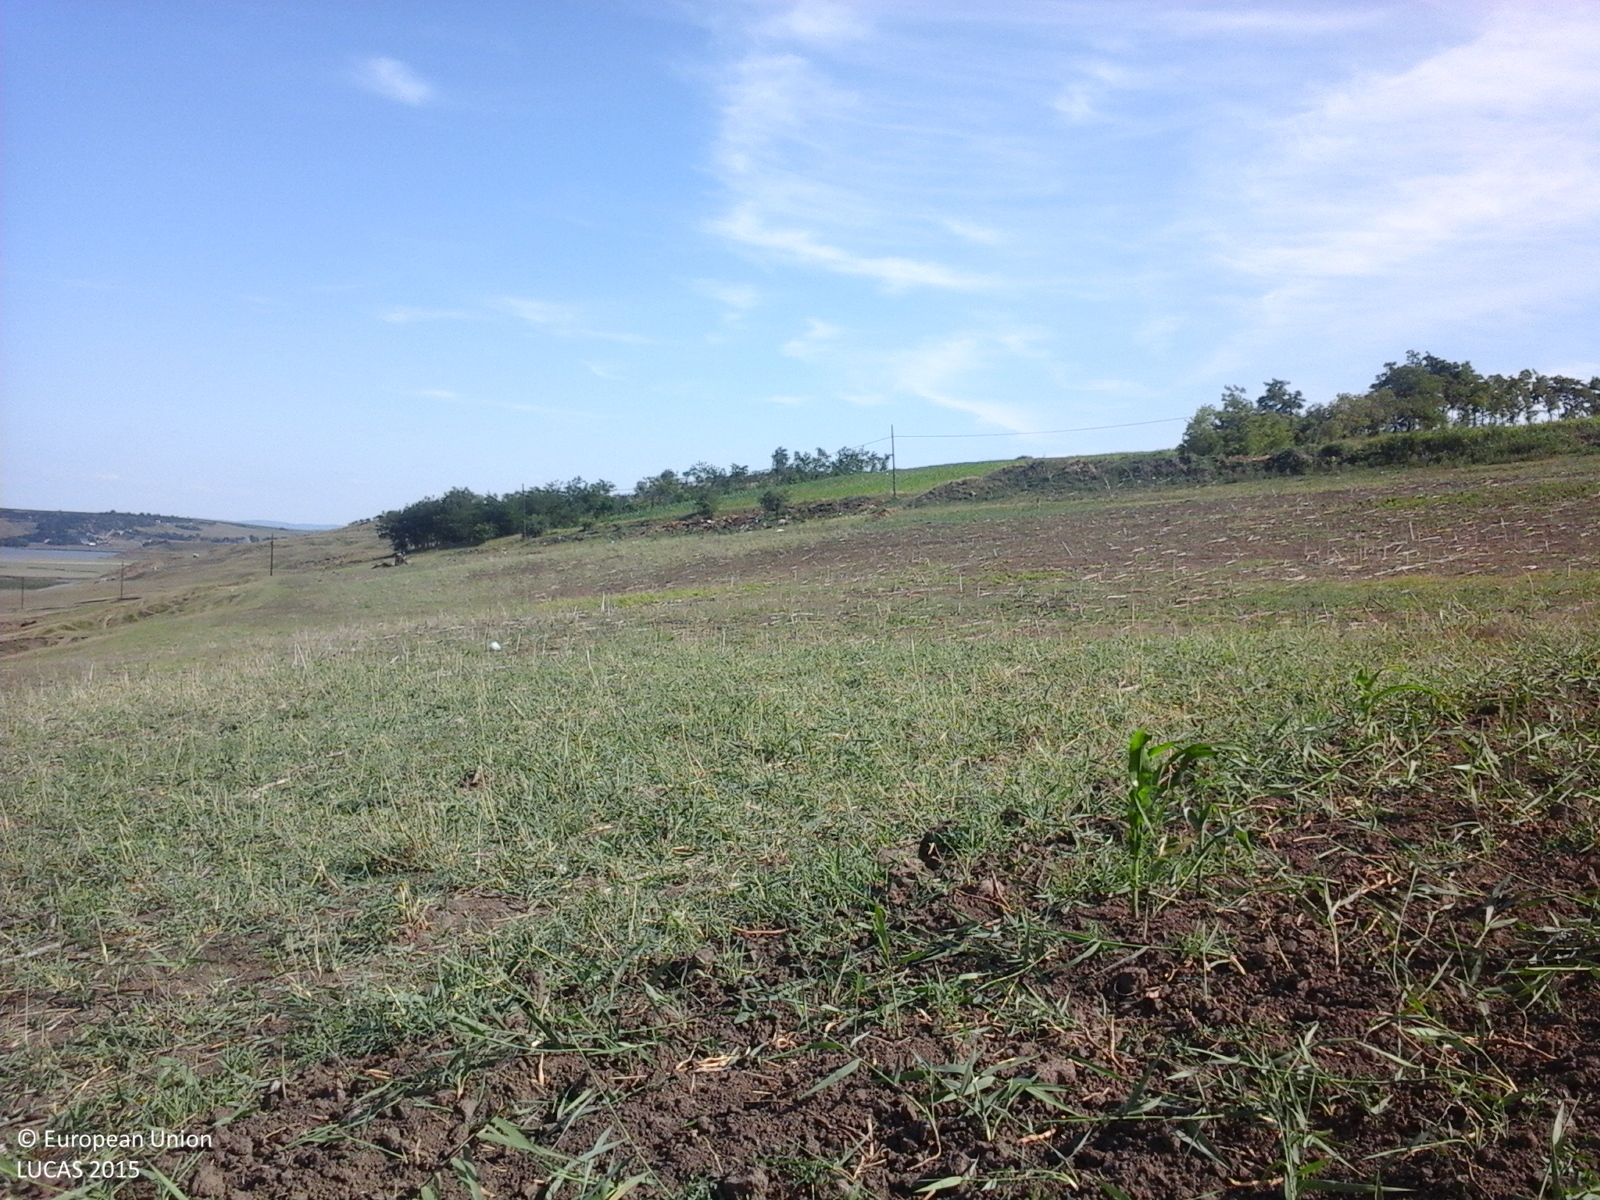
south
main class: Cropland
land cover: Maize
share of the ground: 25 - 50 %
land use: Agriculture (excluding fallow land and kitchen gardens)
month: June
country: RO
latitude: 47.3056
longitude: 27.0464
